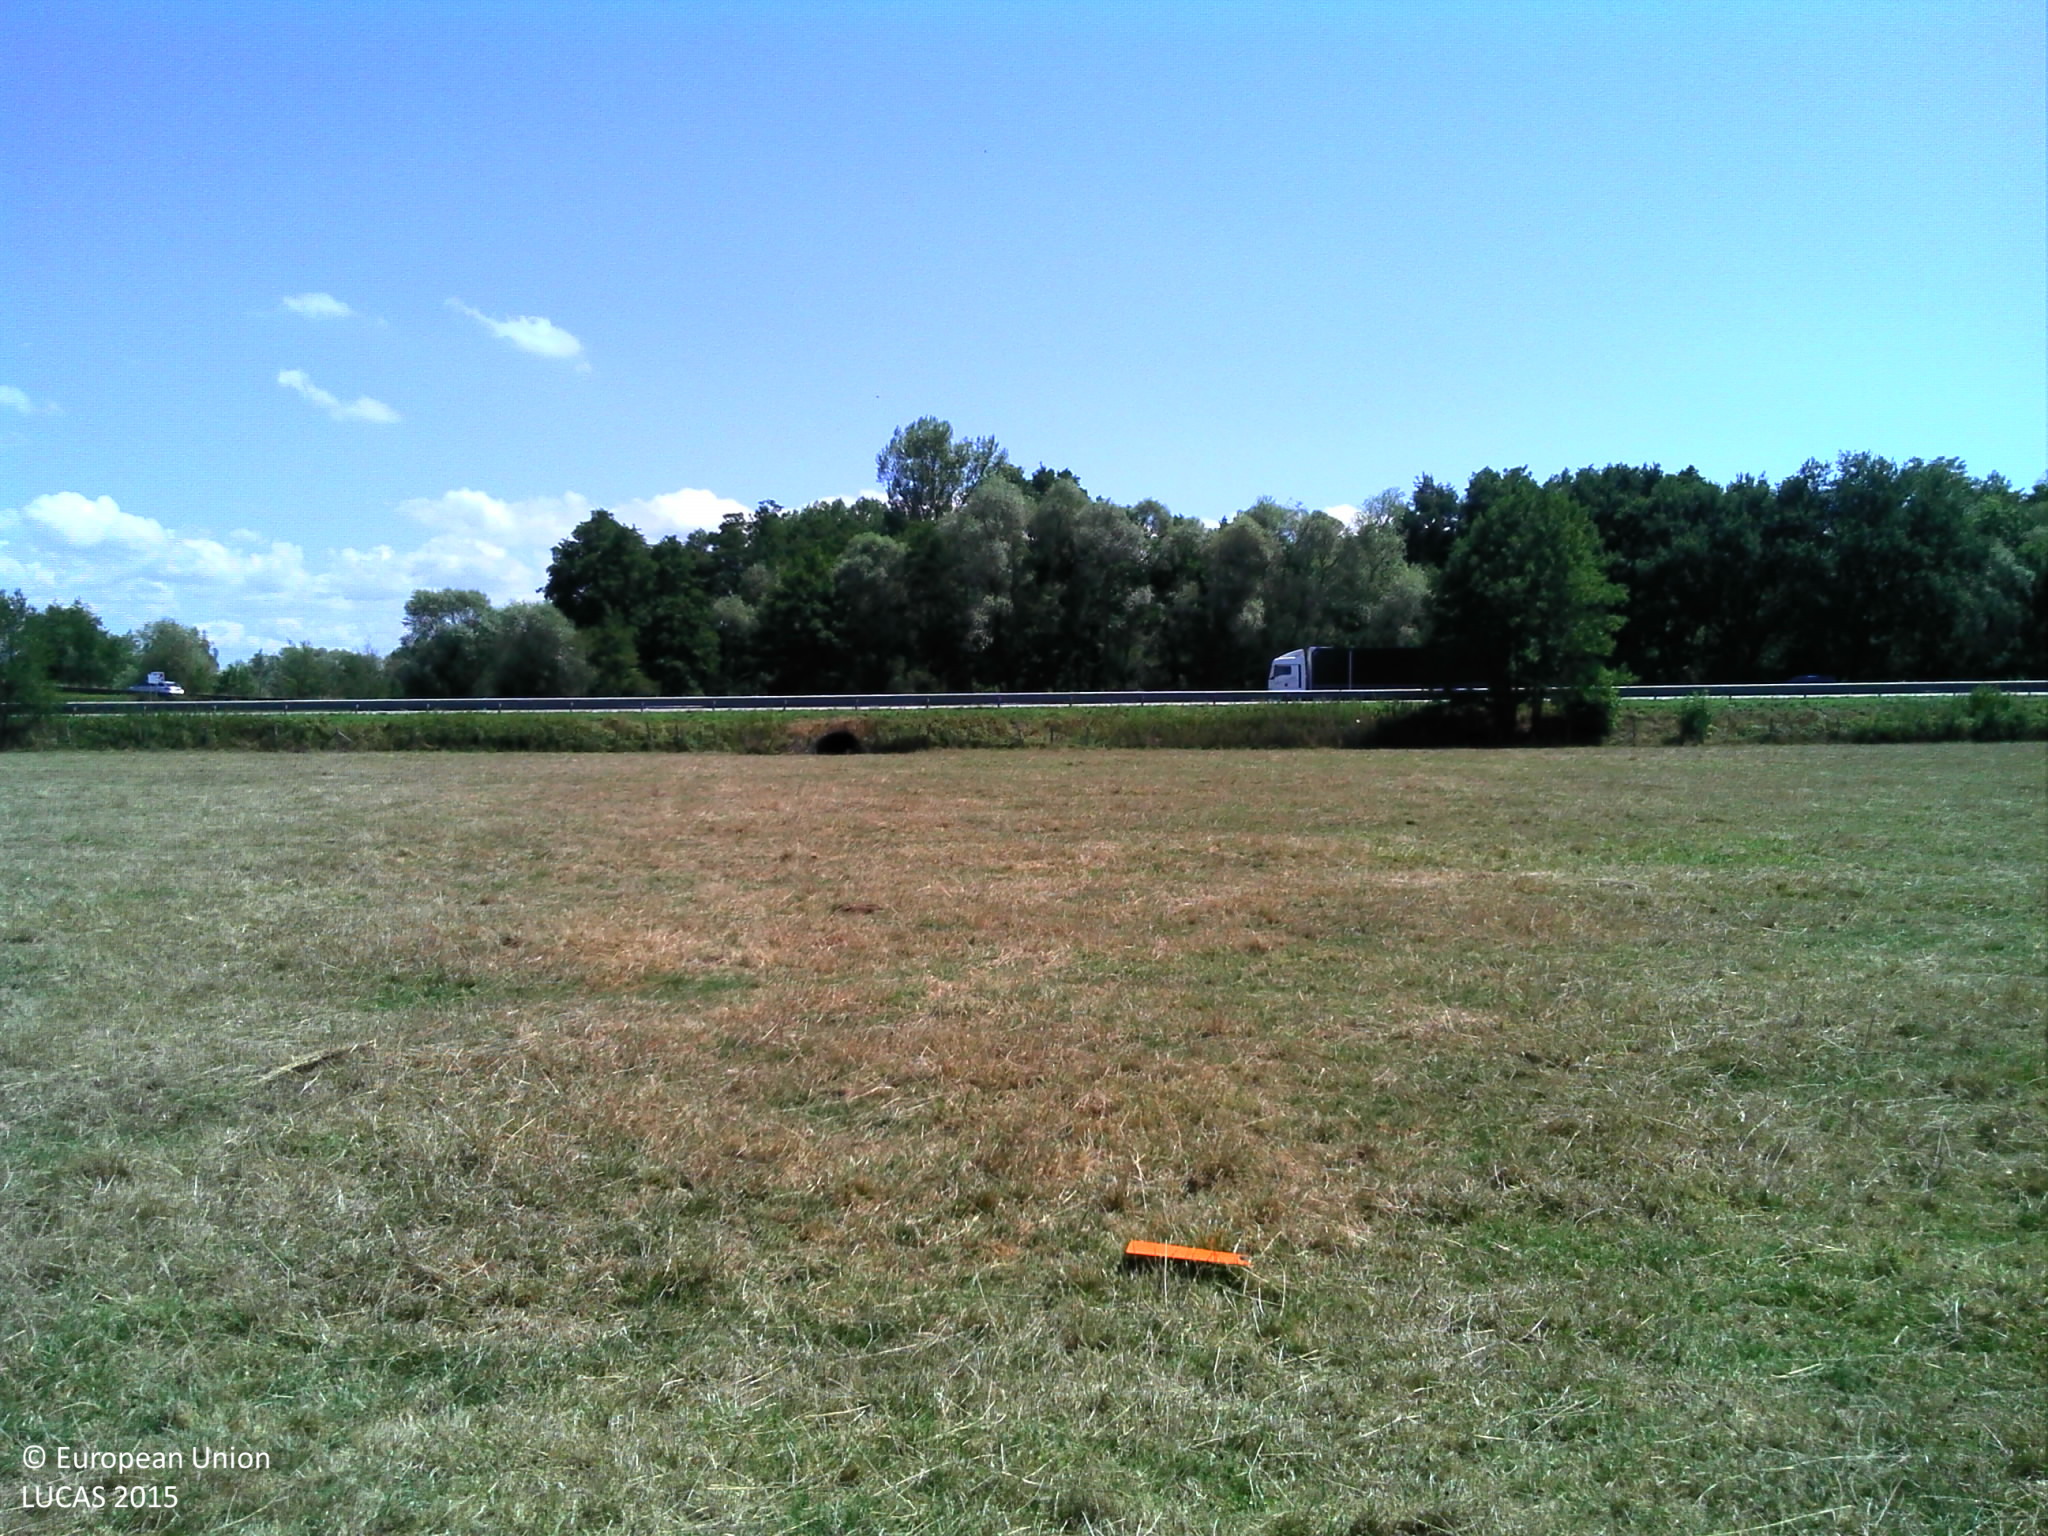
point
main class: Grassland
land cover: Grassland without tree/shrub cover
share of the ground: > 75 %
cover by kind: herbaceous plants 100 %
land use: Agriculture (excluding fallow land and kitchen gardens)
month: August
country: FR
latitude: 48.8543
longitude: 8.0517
